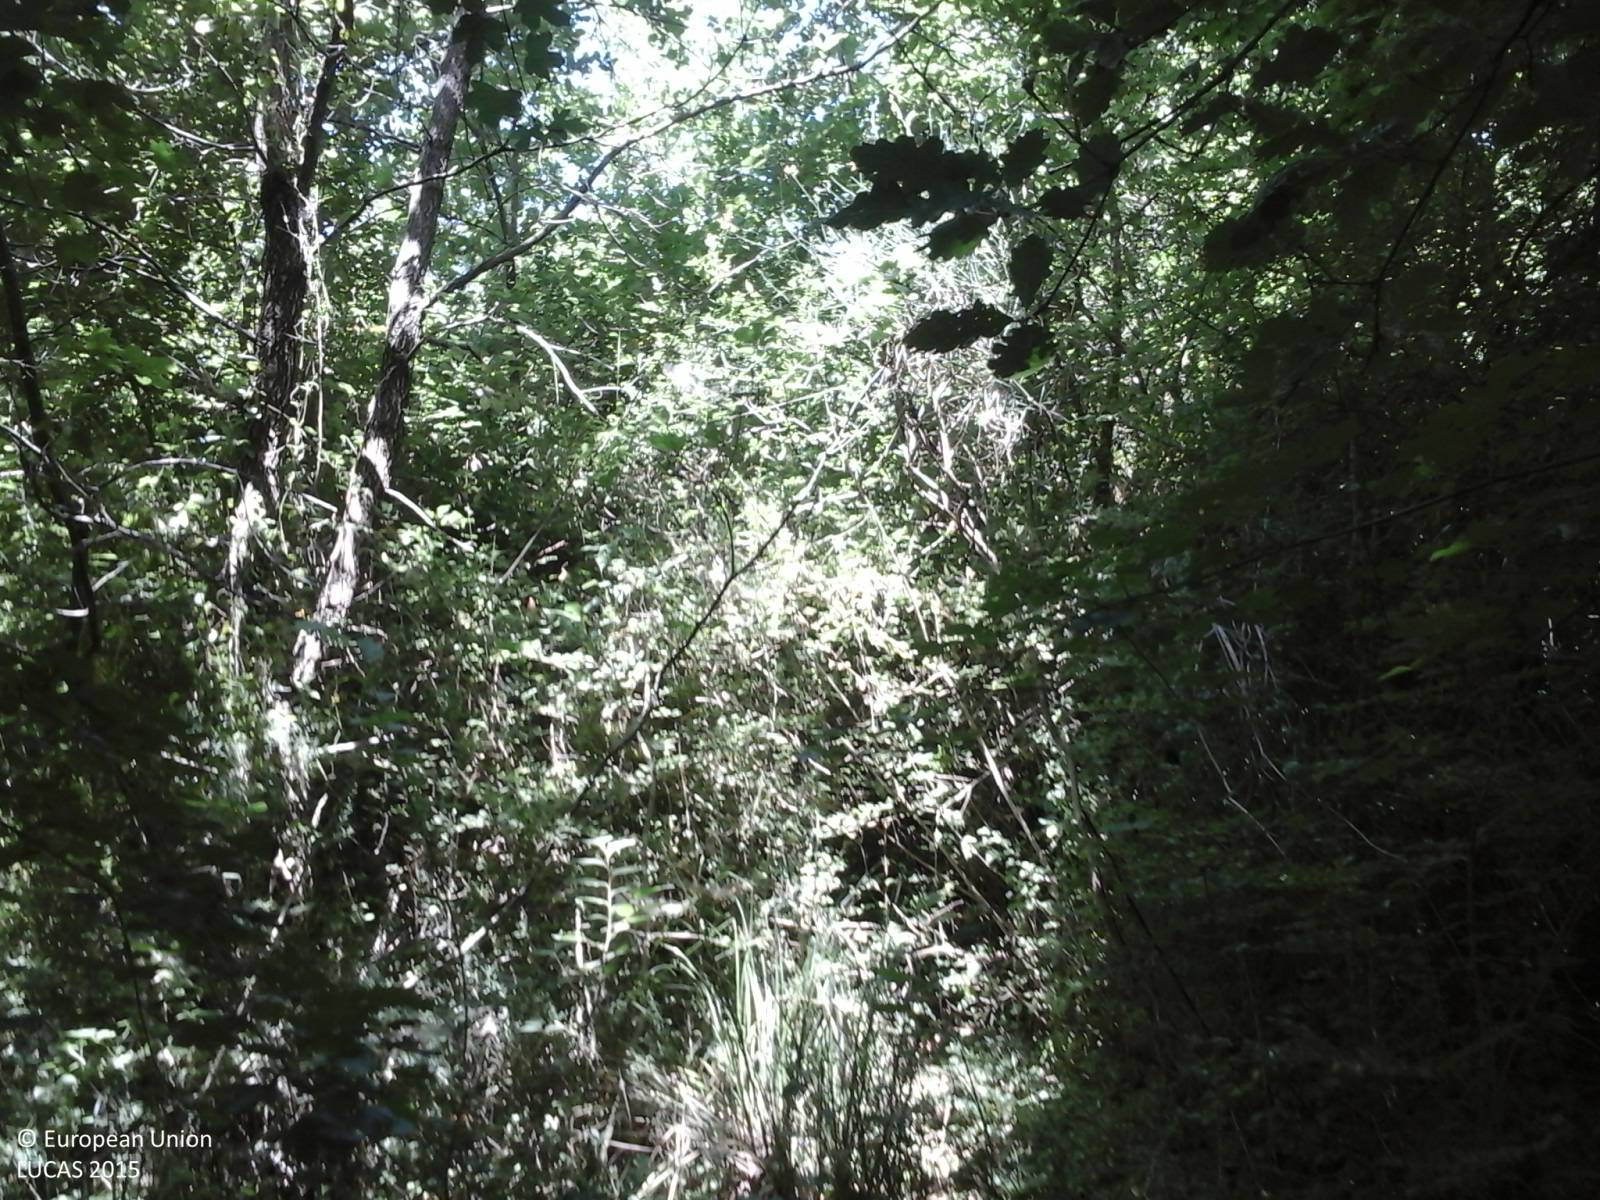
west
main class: Woodland
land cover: Broadleaved woodland
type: thermophilous deciduous forest
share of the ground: > 75 %
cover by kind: broadleaved forest trees 100 %
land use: Forestry
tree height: < 5 m
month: June
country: IT
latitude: 41.3205
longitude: 14.1535
